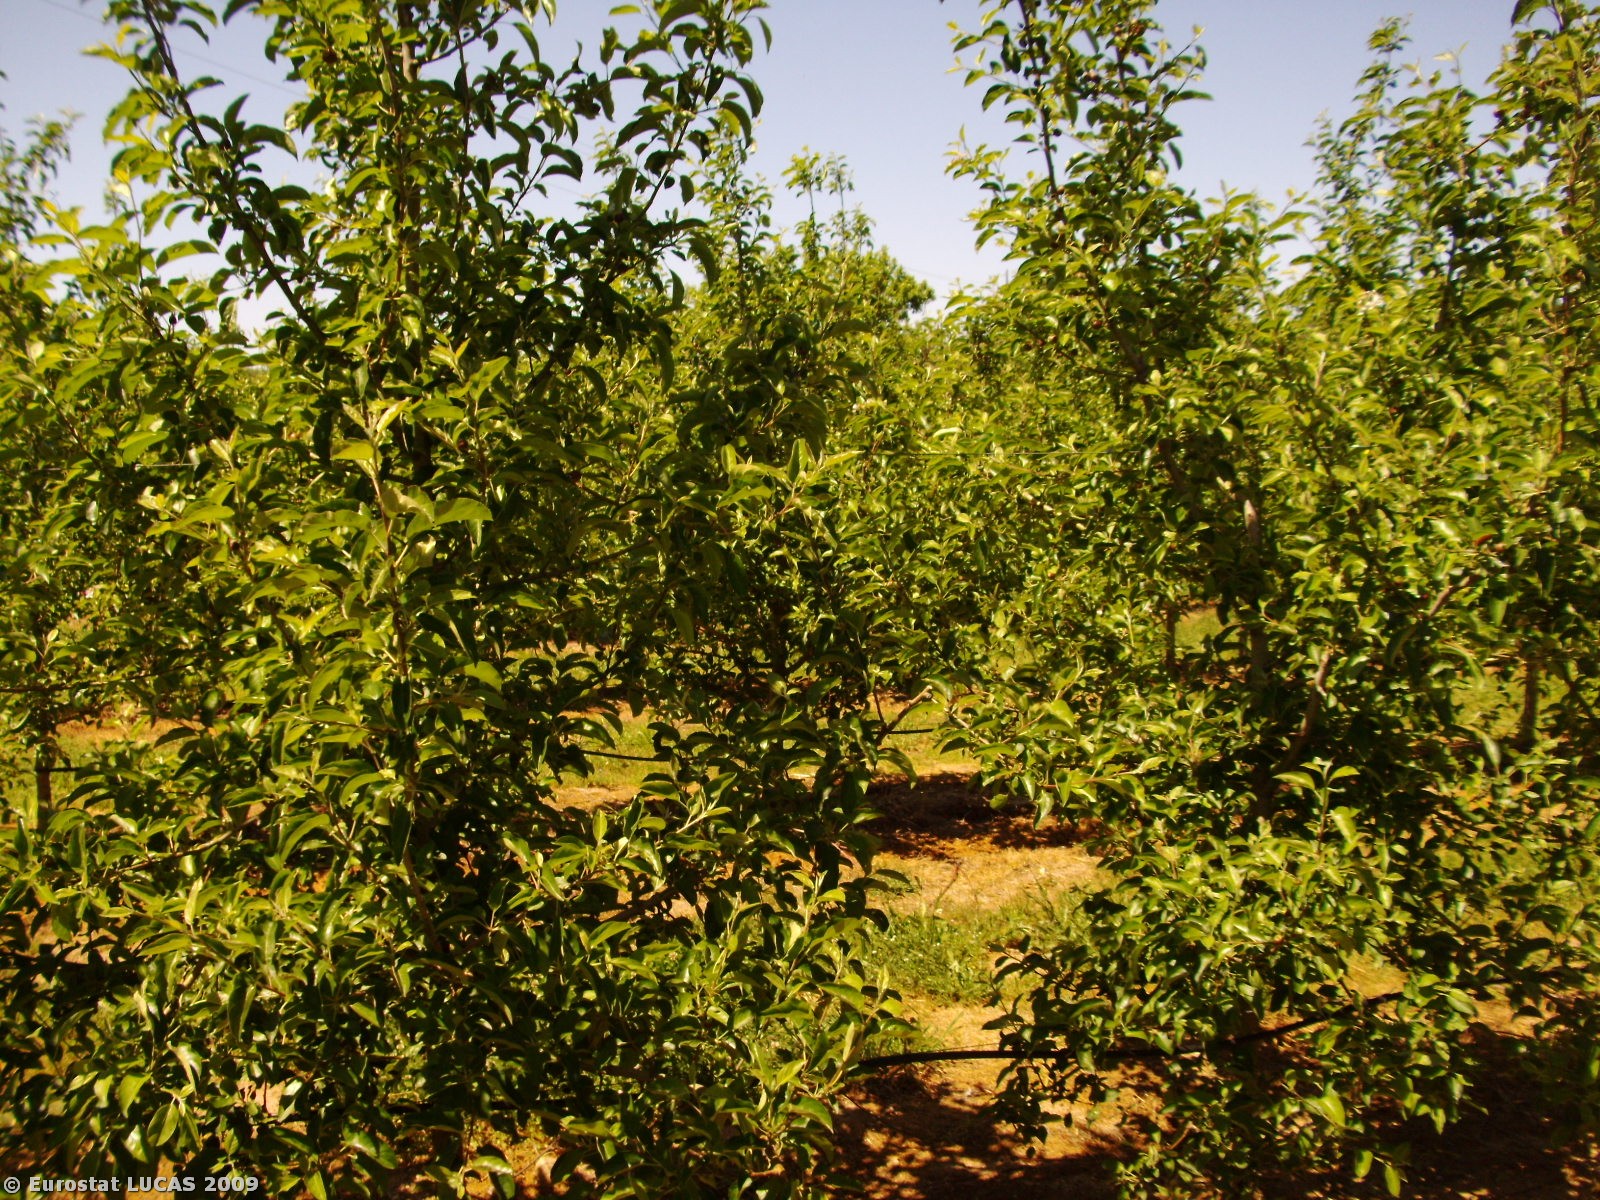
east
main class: Cropland
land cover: Apple fruit
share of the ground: 50 - 75 %
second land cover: Spontaneously vegetated surfaces
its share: 25 - 50 %
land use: Agriculture (excluding fallow land and kitchen gardens)
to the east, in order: Apple fruit; Single bushes/trees; Apple fruit; Tracks; Spontaneously vegetated surfaces; Shruby margins; Dry stone walls; Spontaneously vegetated surfaces; Paved roads, cycling and walking lanes; Dry stone walls; Potatoes; Dry stone walls; Dry pulses; Fences; Broadleaved woodland; Potatoes; Other structural elements; Tracks; Potatoes; Maize; Dry stone walls; Rivers and streams; Dry stone walls; Broadleaved woodland; Rye; Fences; Grassland without tree/shrub cover
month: May
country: PT
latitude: 40.9382
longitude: -7.5679
